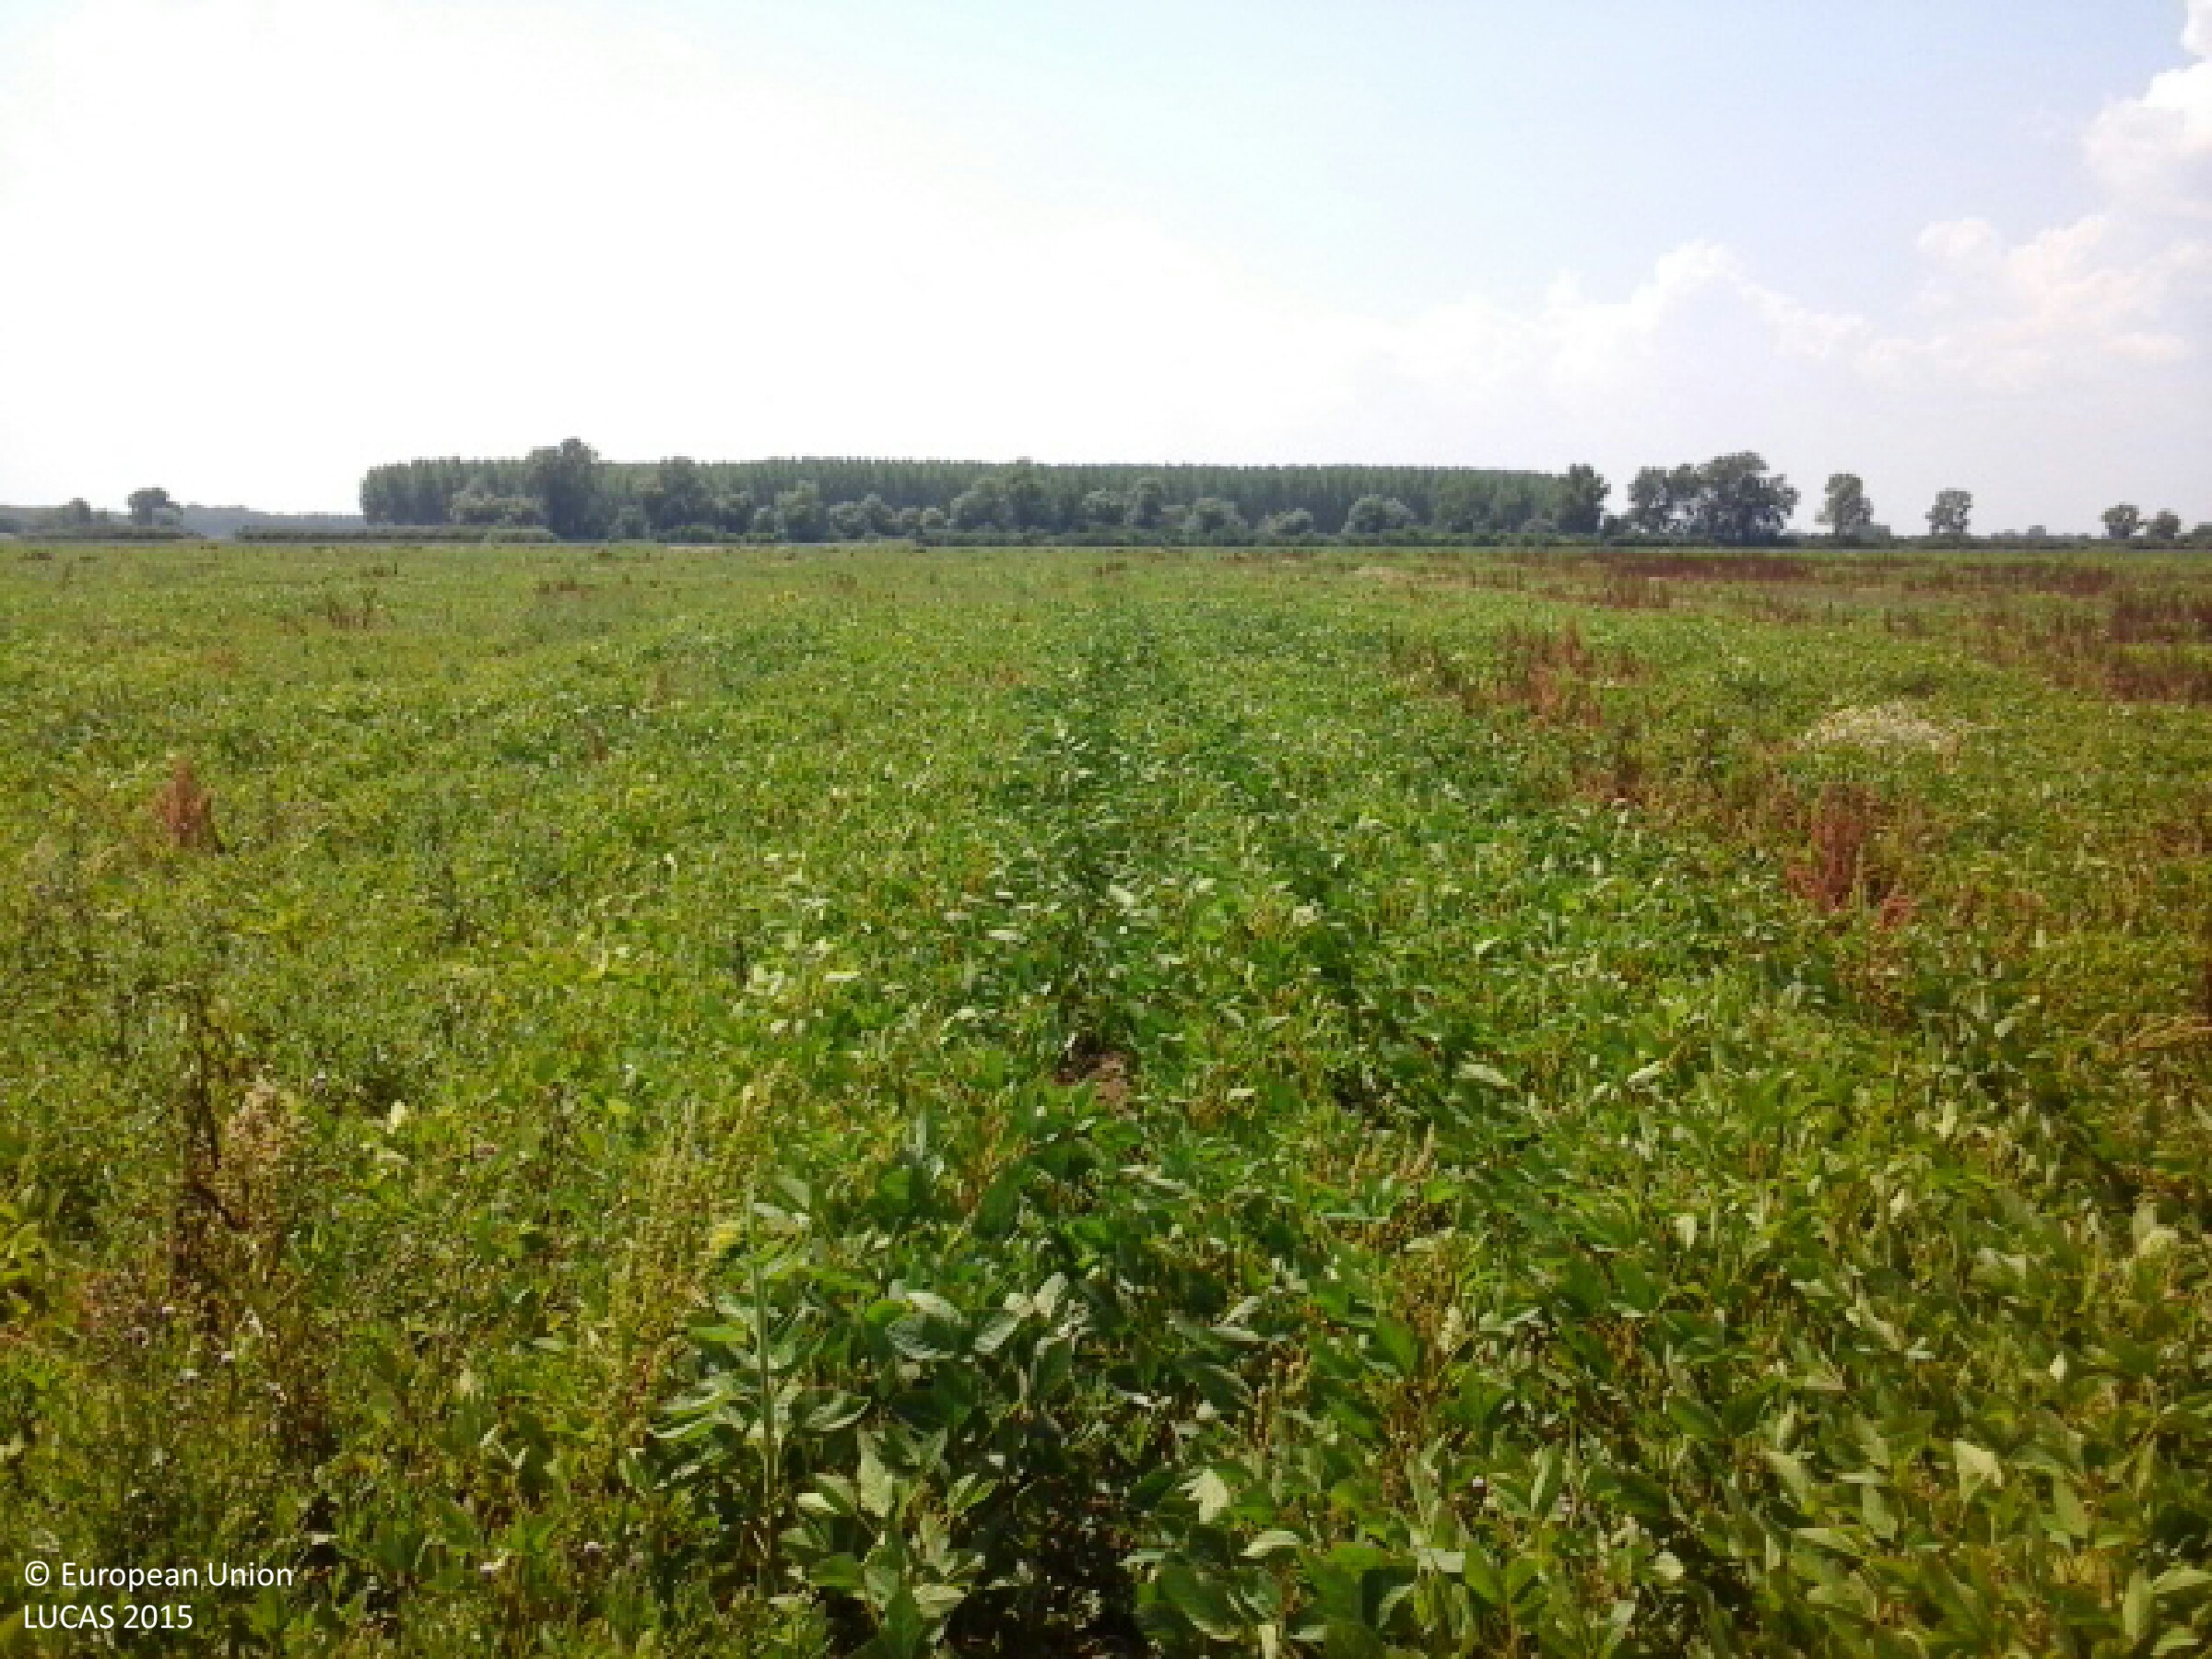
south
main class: Cropland
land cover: Soya
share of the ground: > 75 %
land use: Agriculture (excluding fallow land and kitchen gardens)
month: July
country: HU
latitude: 48.3793
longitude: 21.1814
